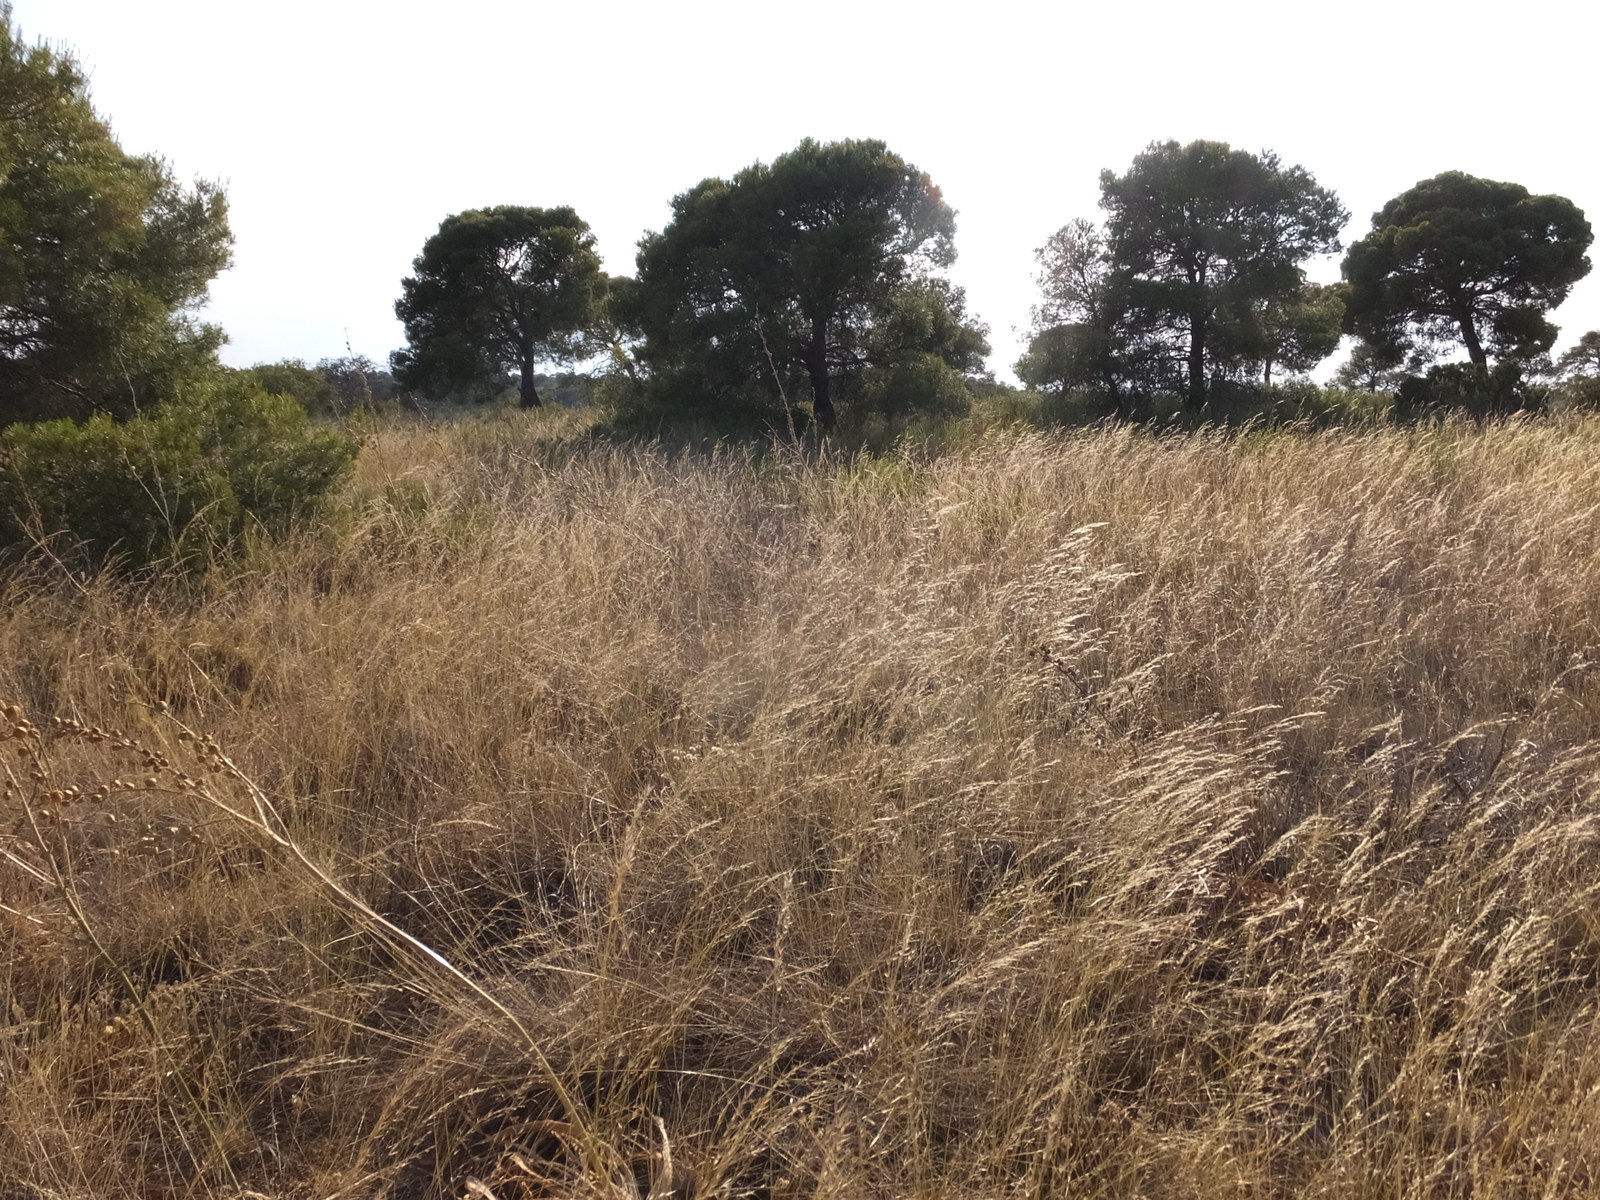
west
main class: Grassland
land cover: Grassland with sparse tree/shrub cover
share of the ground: > 75 %
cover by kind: herbaceous plants 85 %, shrubs 10 %, coniferous forest trees 5 %
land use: Abandoned areas
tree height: > 5 m
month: June
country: ES
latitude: 41.2779
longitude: -0.2456
